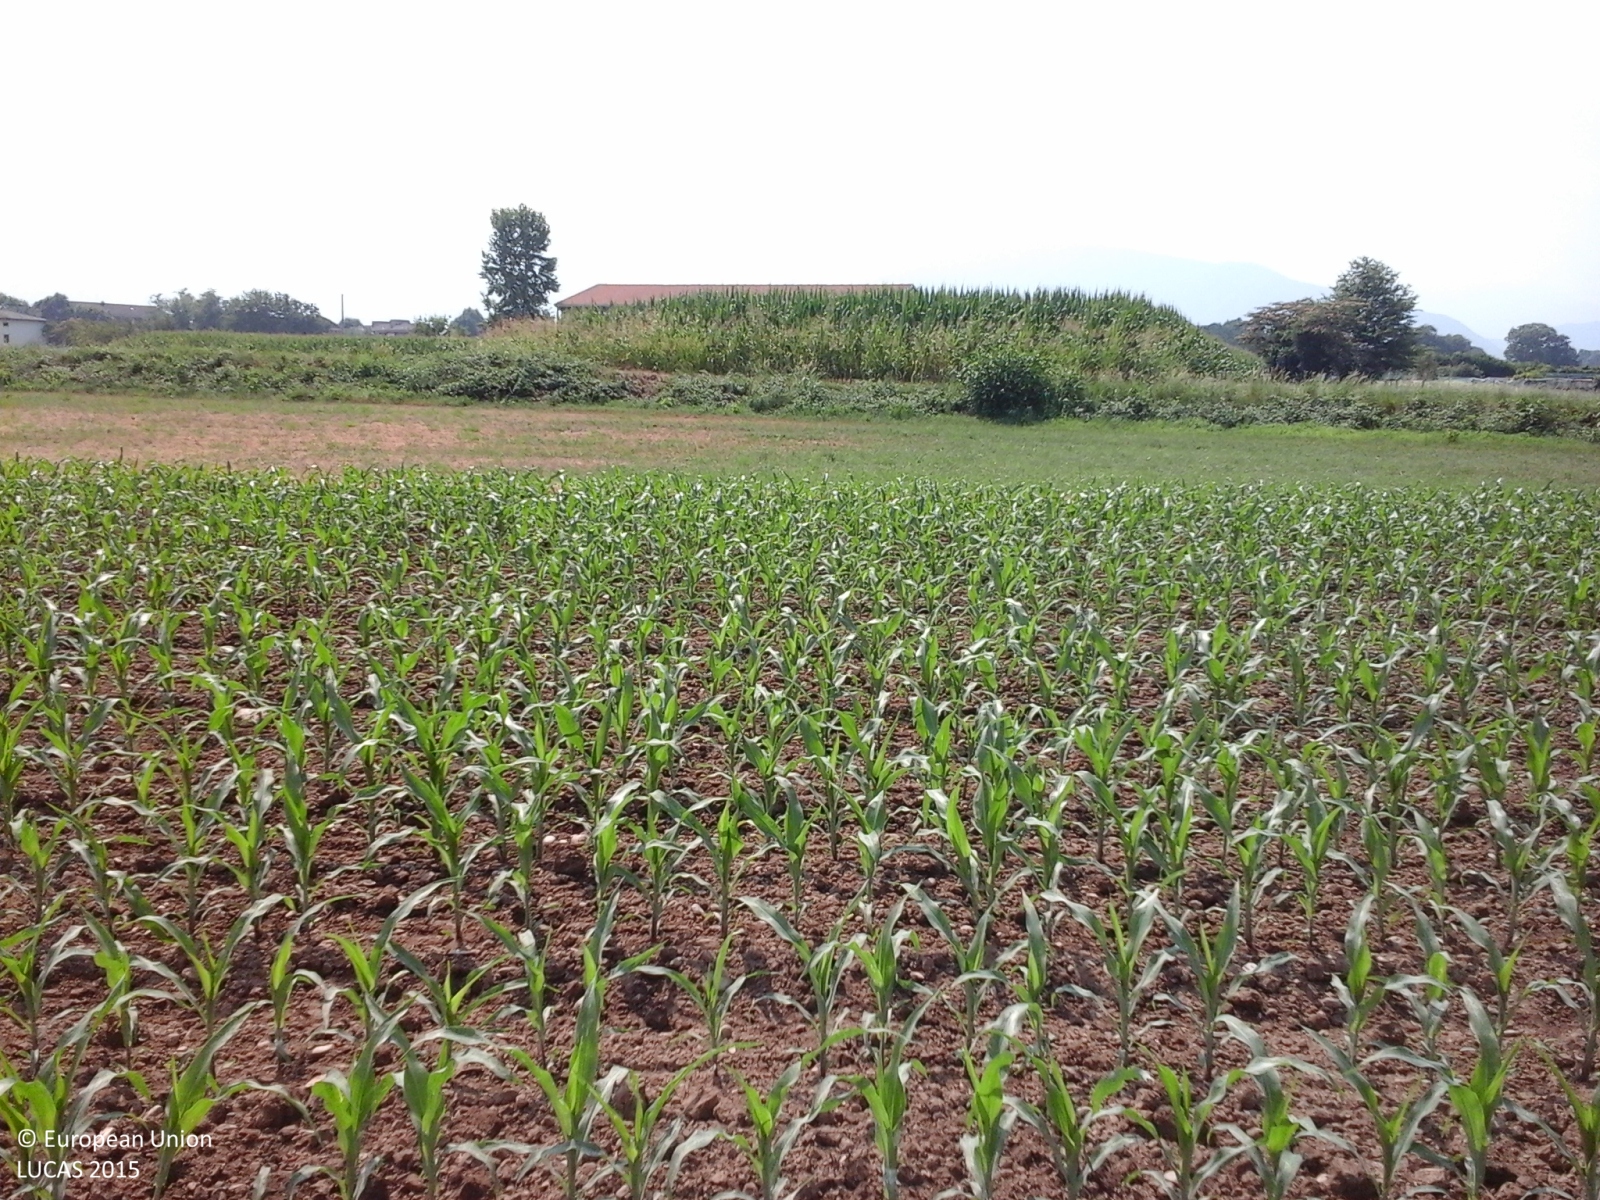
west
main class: Cropland
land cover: Maize
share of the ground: 25 - 50 %
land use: Agriculture (excluding fallow land and kitchen gardens)
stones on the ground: < 10 %
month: July
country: IT
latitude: 45.2427
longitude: 7.5962
